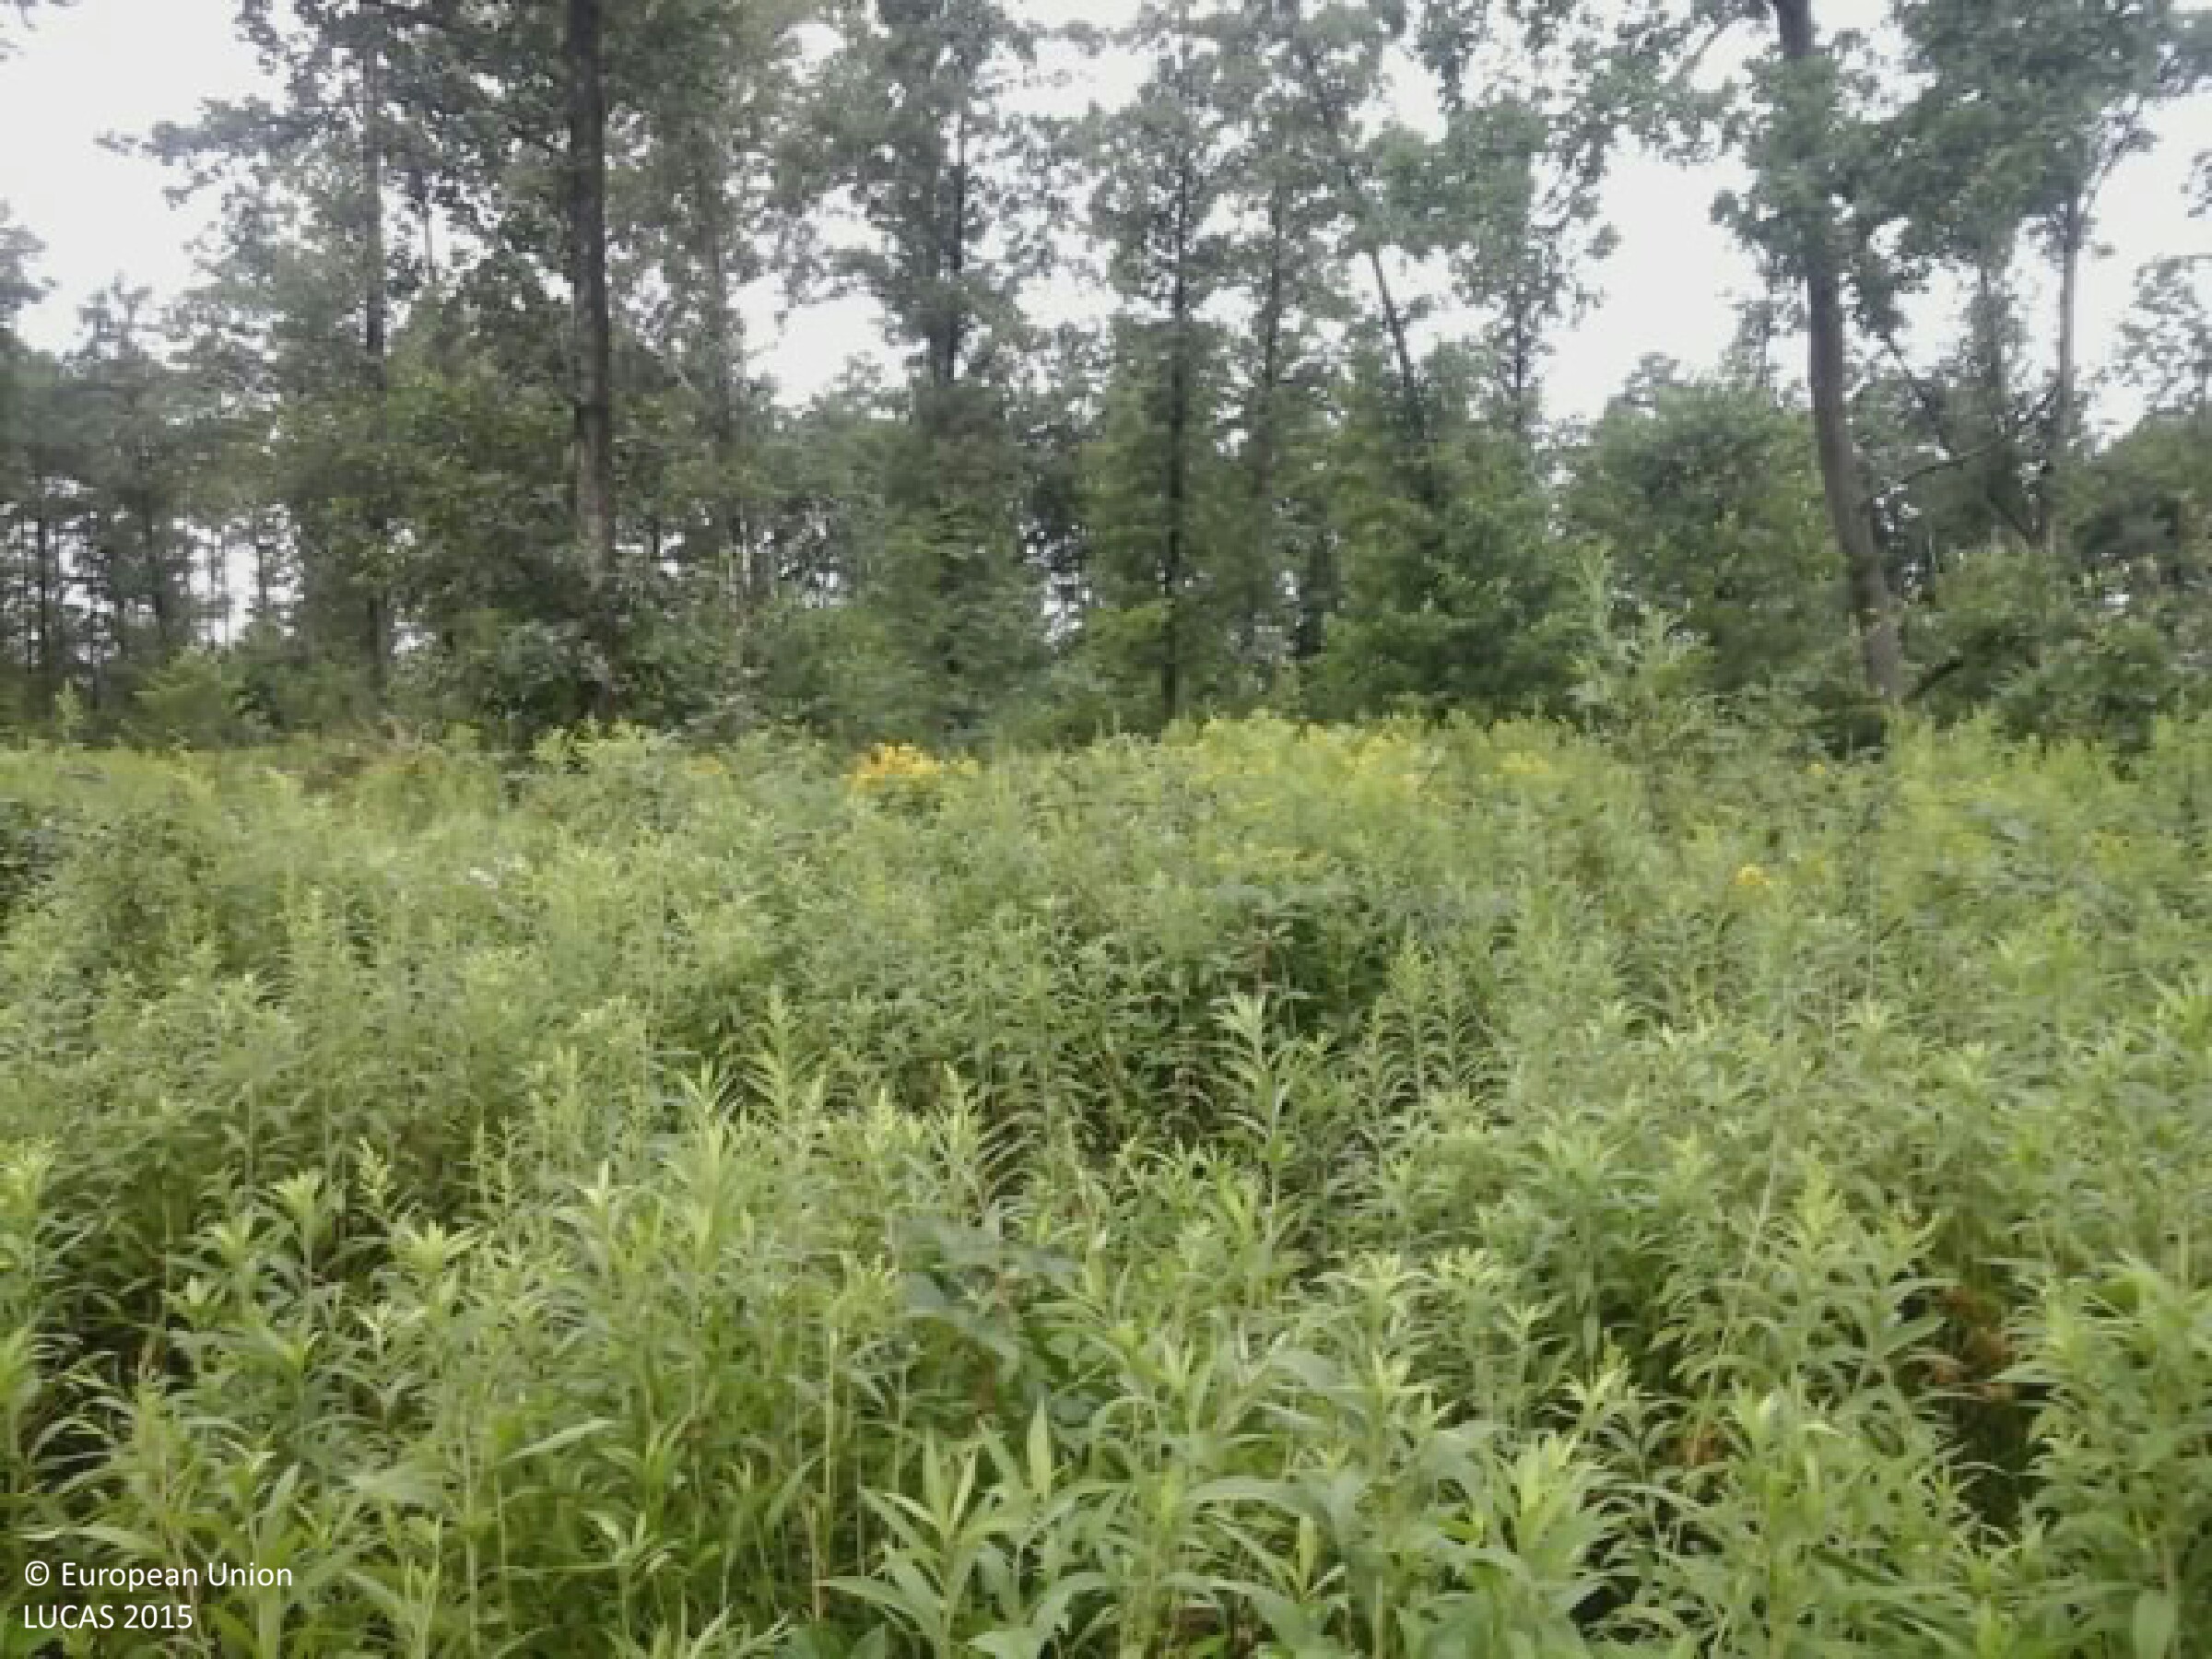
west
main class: Shrubland
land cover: Shrubland without tree cover
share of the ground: 50 - 75 %
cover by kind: shrubs 65 %, herbaceous plants 35 %
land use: Forestry
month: July
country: HU
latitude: 46.3910
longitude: 17.2991
